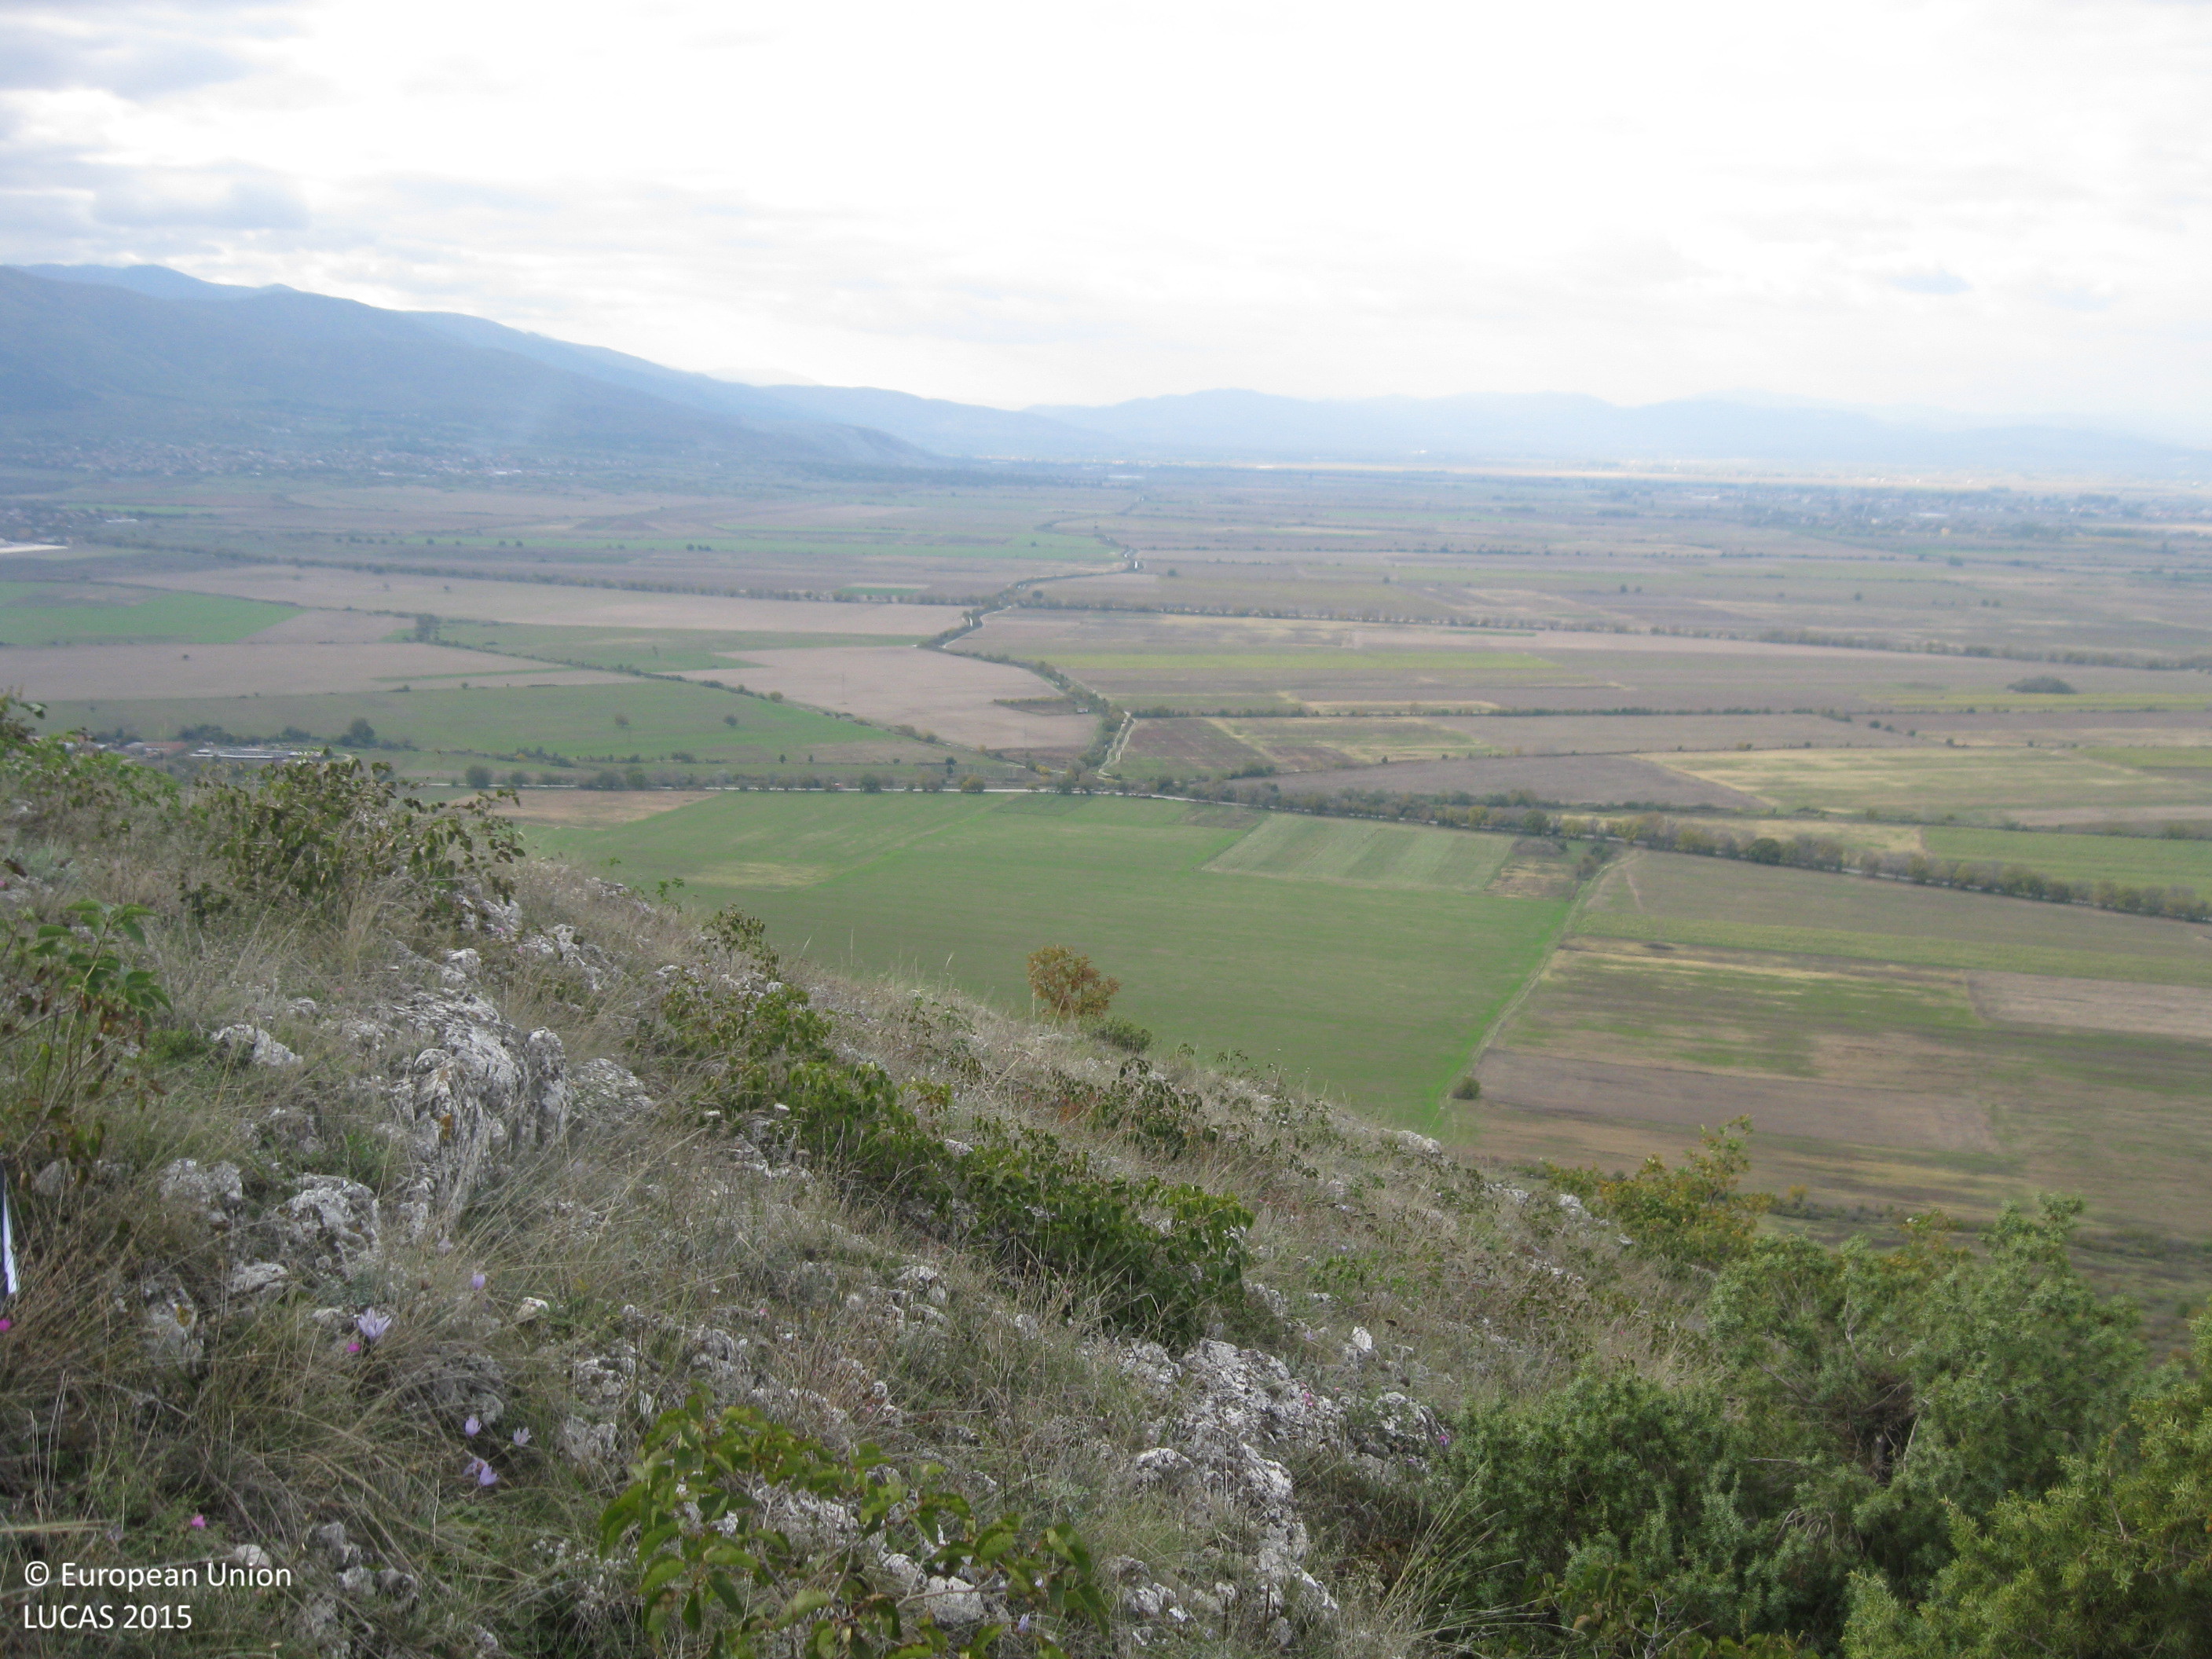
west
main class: Grassland
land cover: Grassland with sparse tree/shrub cover
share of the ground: > 75 %
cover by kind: herbaceous plants 80 %, shrubs 10 %, broadleaved forest trees 5 %, lichens and mosses 5 %
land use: Semi-natural and natural areas not in use
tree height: < 5 m
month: October
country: BG
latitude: 42.1127
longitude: 24.2777
